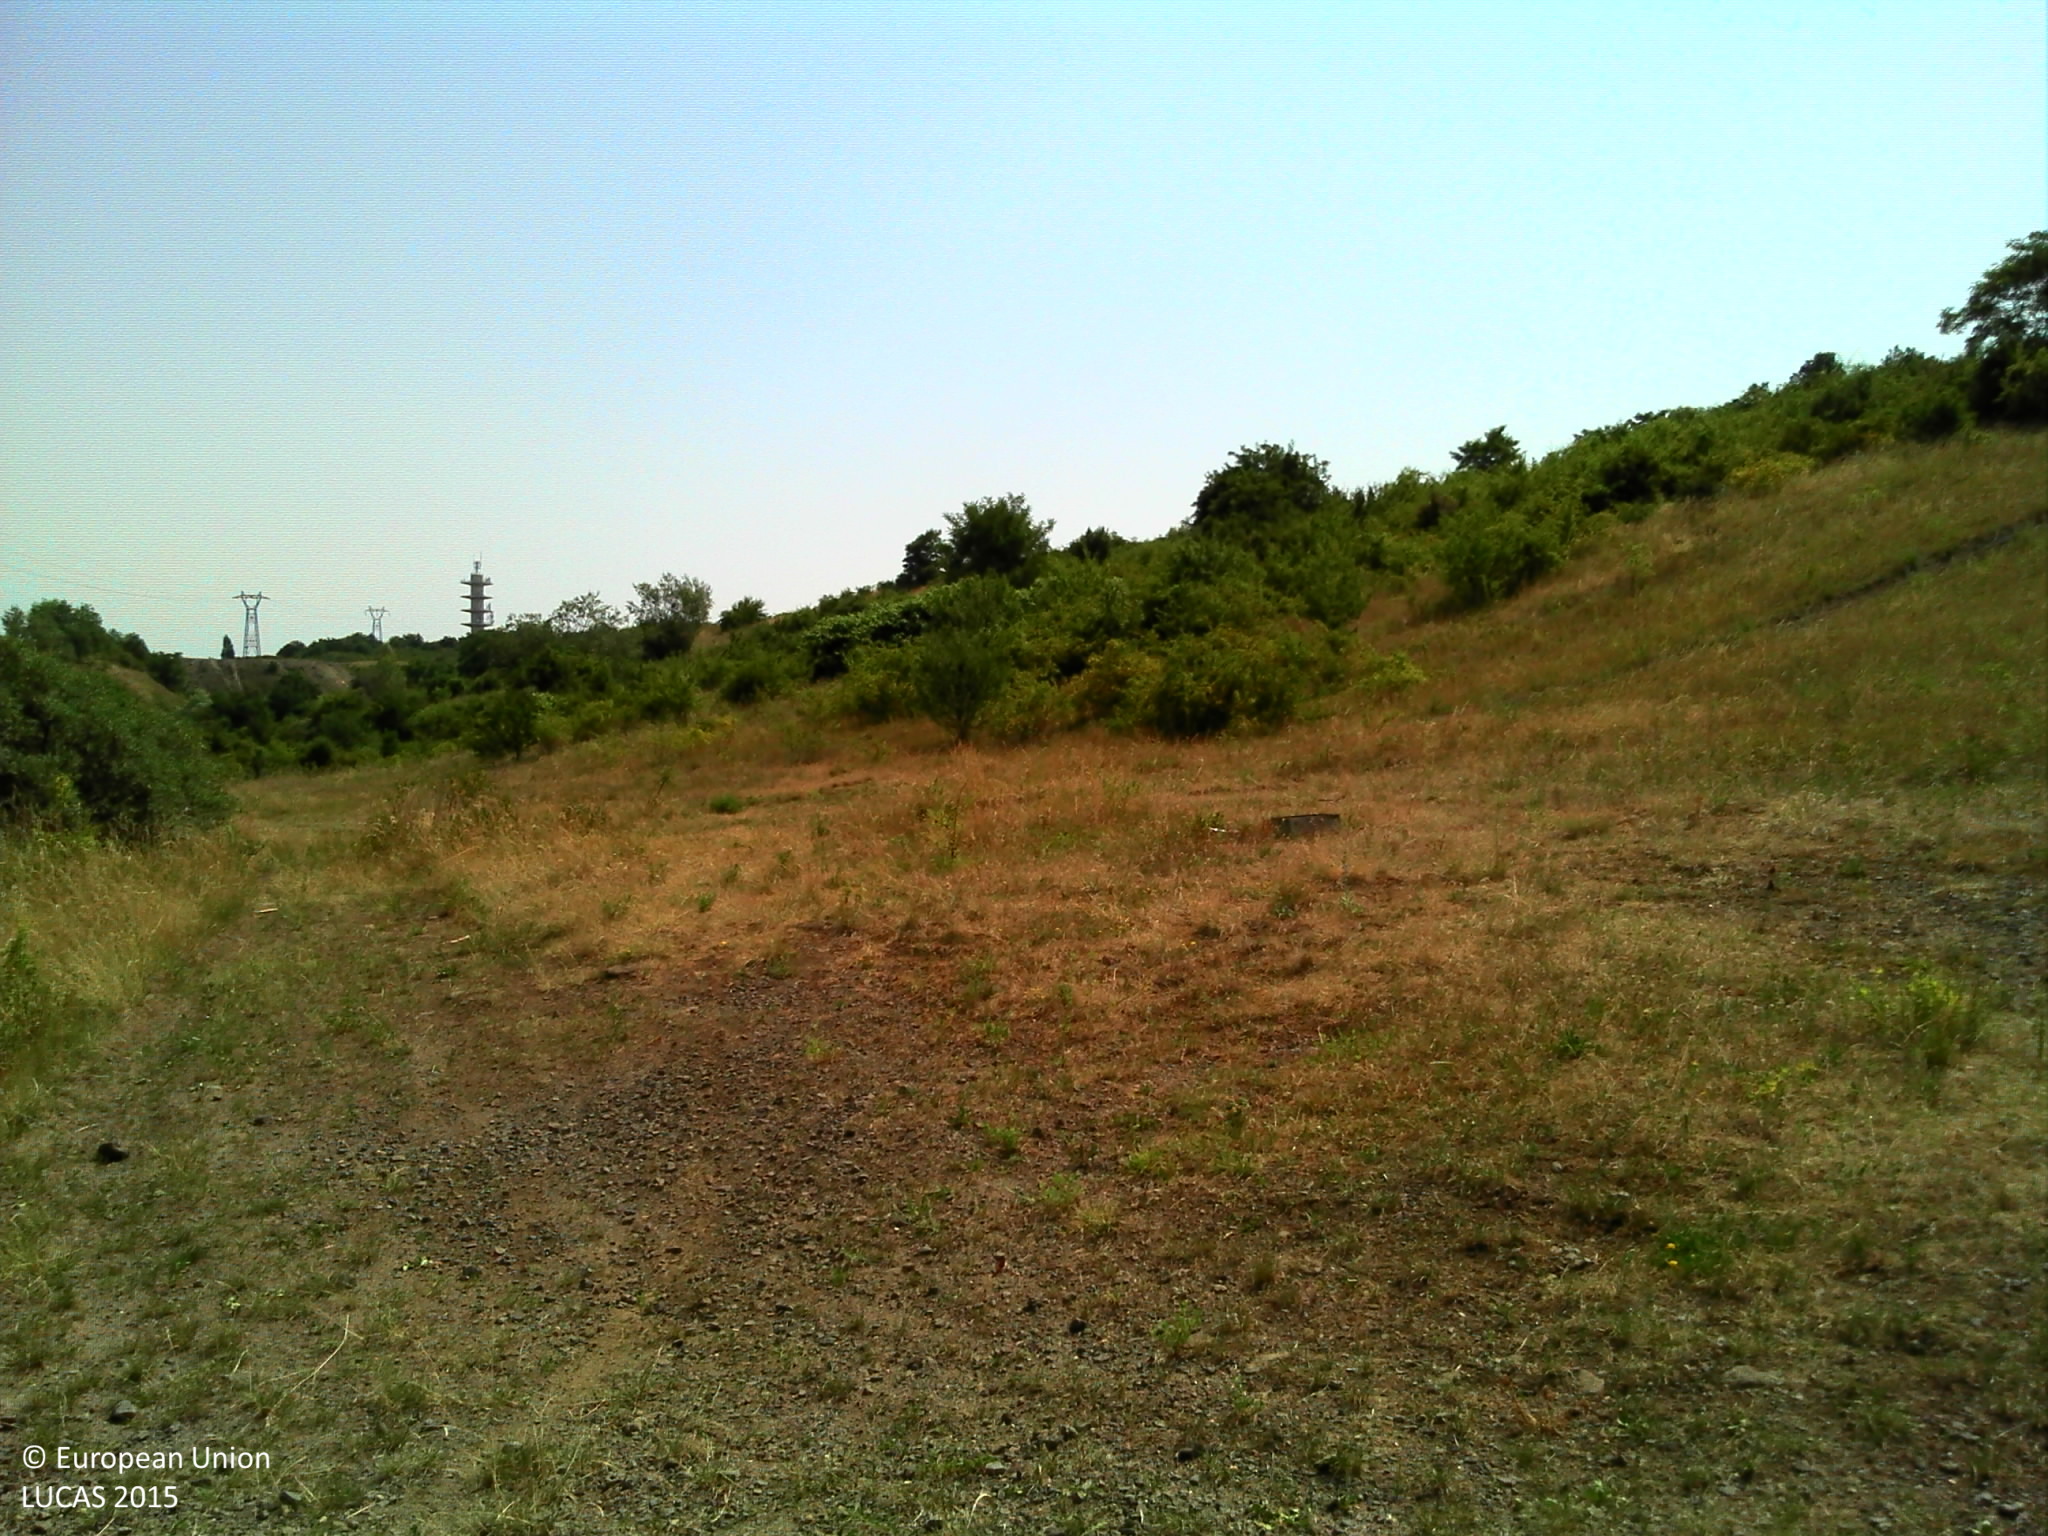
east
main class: Shrubland
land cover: Shrubland without tree cover
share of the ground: > 75 %
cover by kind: herbaceous plants 70 %, shrubs 30 %
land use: Sport
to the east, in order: Tracks; Shrubland without tree cover; Tracks; Shrubland with sparse tree cover; Tracks; Shrubland with sparse tree cover; Tracks; Shrubland without tree cover; Tracks; Shrubland without tree cover
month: July
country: FR
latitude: 45.8006
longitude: 3.0646
